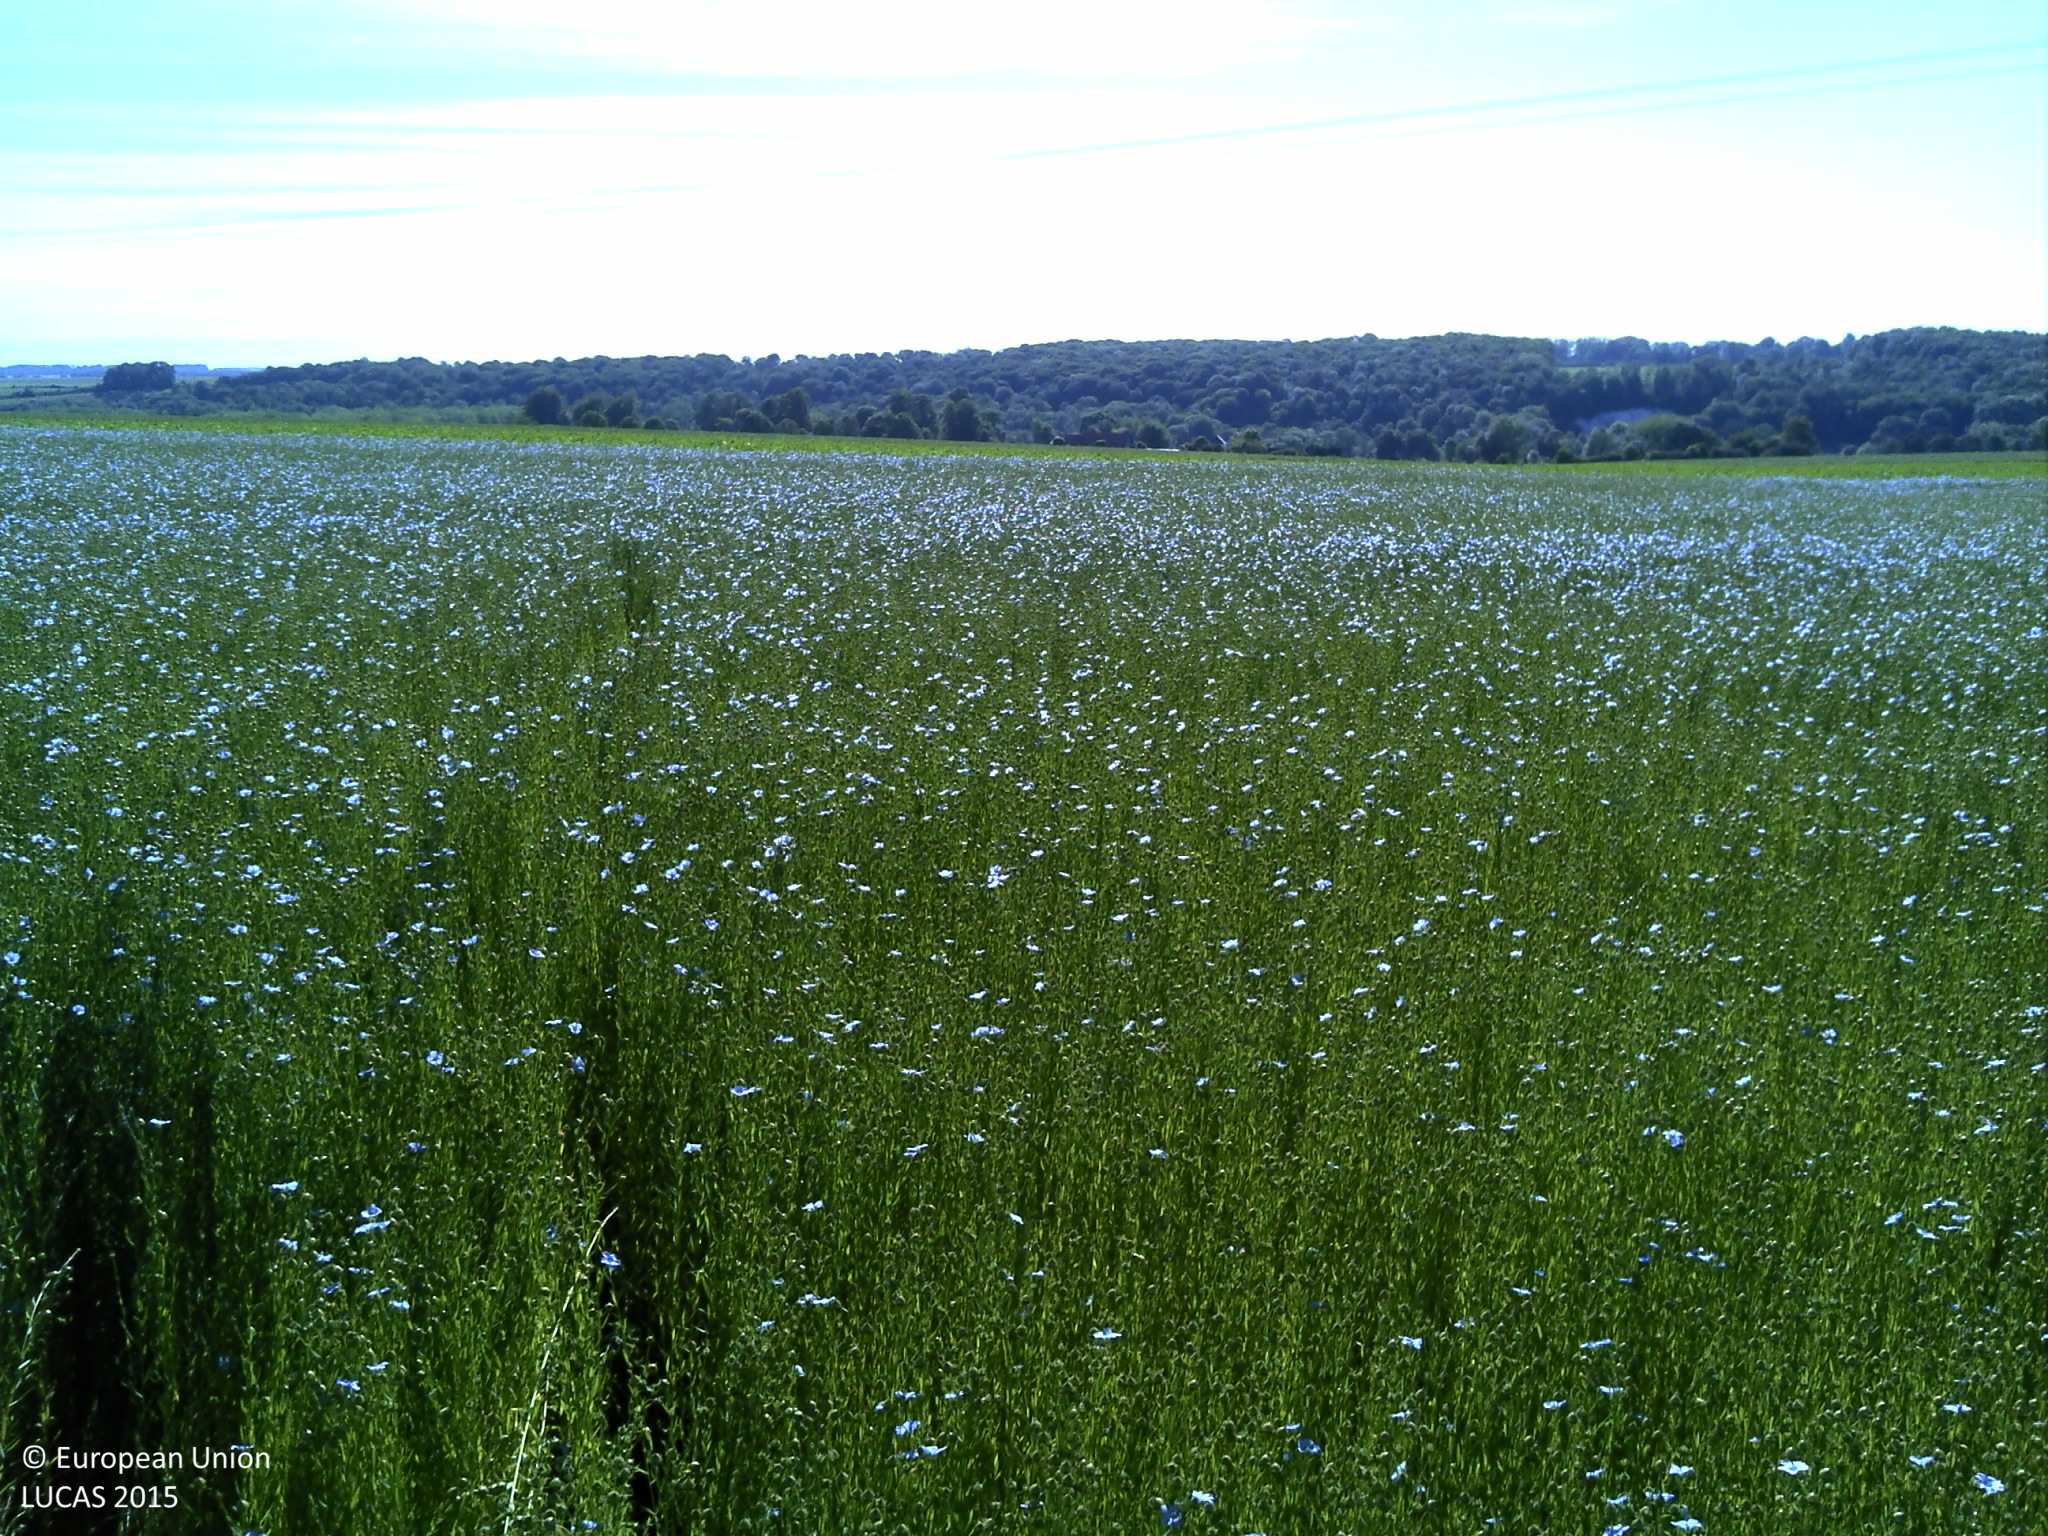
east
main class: Cropland
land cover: Other fibre and oleaginous crops
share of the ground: > 75 %
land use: Agriculture (excluding fallow land and kitchen gardens)
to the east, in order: Other fibre and oleaginous crops; Sugar beet; Electric lines; Sugar beet; Potatoes
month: June
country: FR
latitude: 49.8041
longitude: 0.9314
